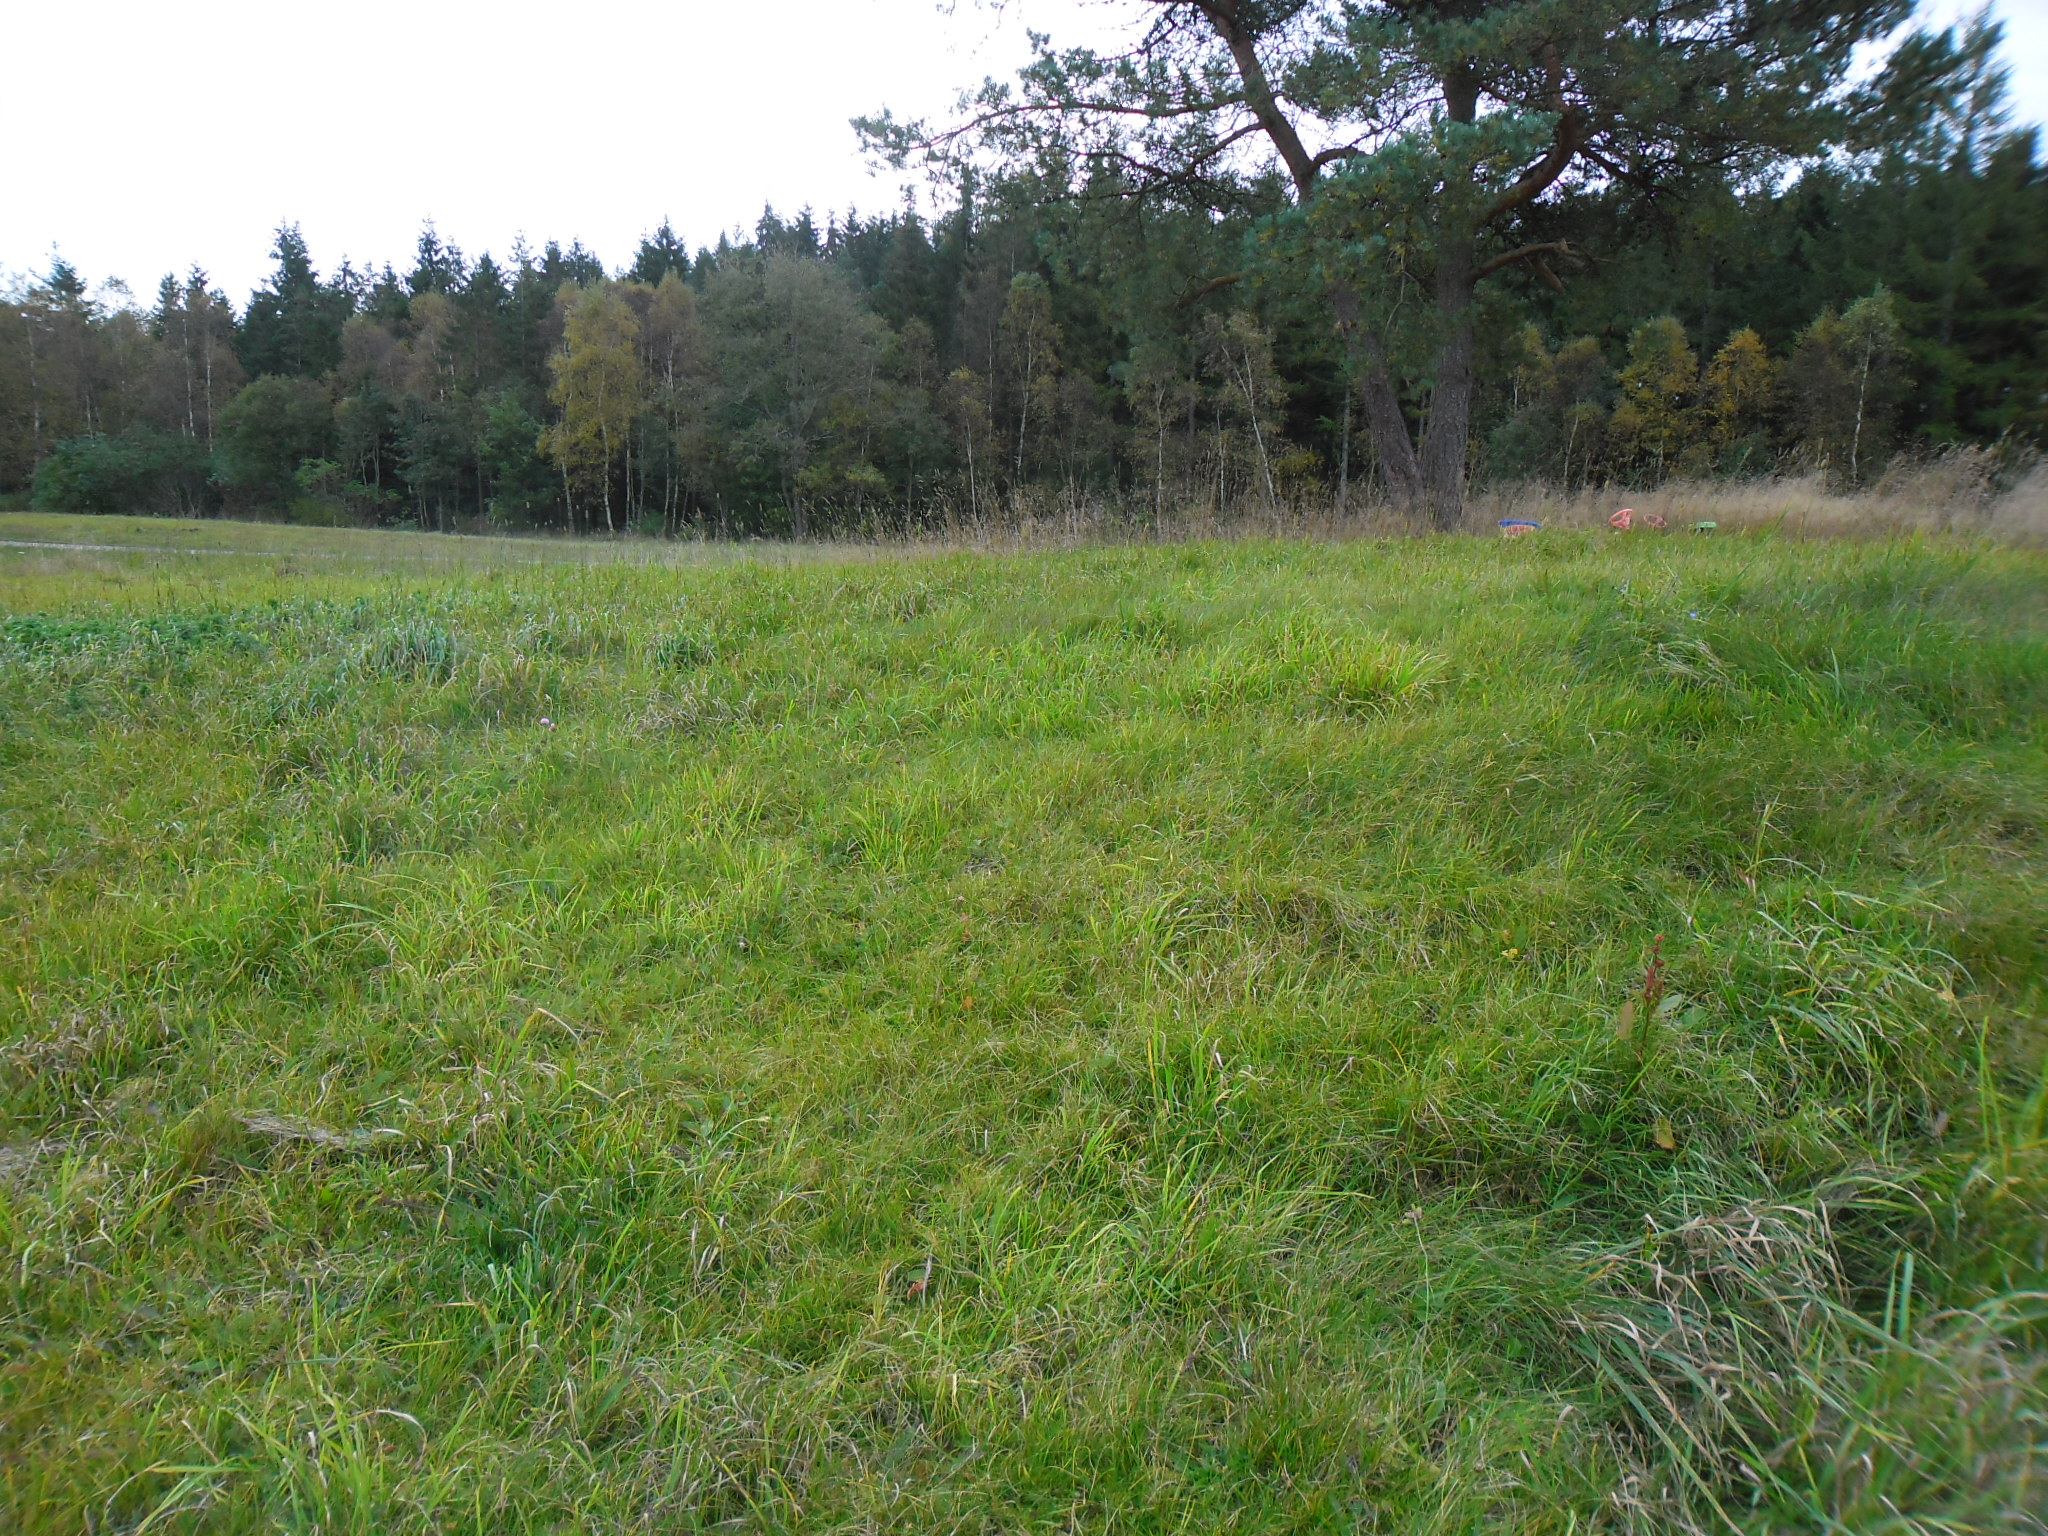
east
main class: Grassland
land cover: Grassland without tree/shrub cover
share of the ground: > 75 %
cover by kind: herbaceous plants 100 %
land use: Agriculture (excluding fallow land and kitchen gardens)
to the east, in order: Grassland without tree/shrub cover; Paved roads, cycling and walking lanes; Grassland without tree/shrub cover; Broadleaved woodland; Dry stone walls; Broadleaved woodland; Rivers and streams; Spruce dominated coniferous woodland; Broadleaved woodland; Spruce dominated coniferous woodland; Dry stone walls; Spruce dominated coniferous woodland
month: October
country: SE
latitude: 56.5617
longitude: 13.2025
